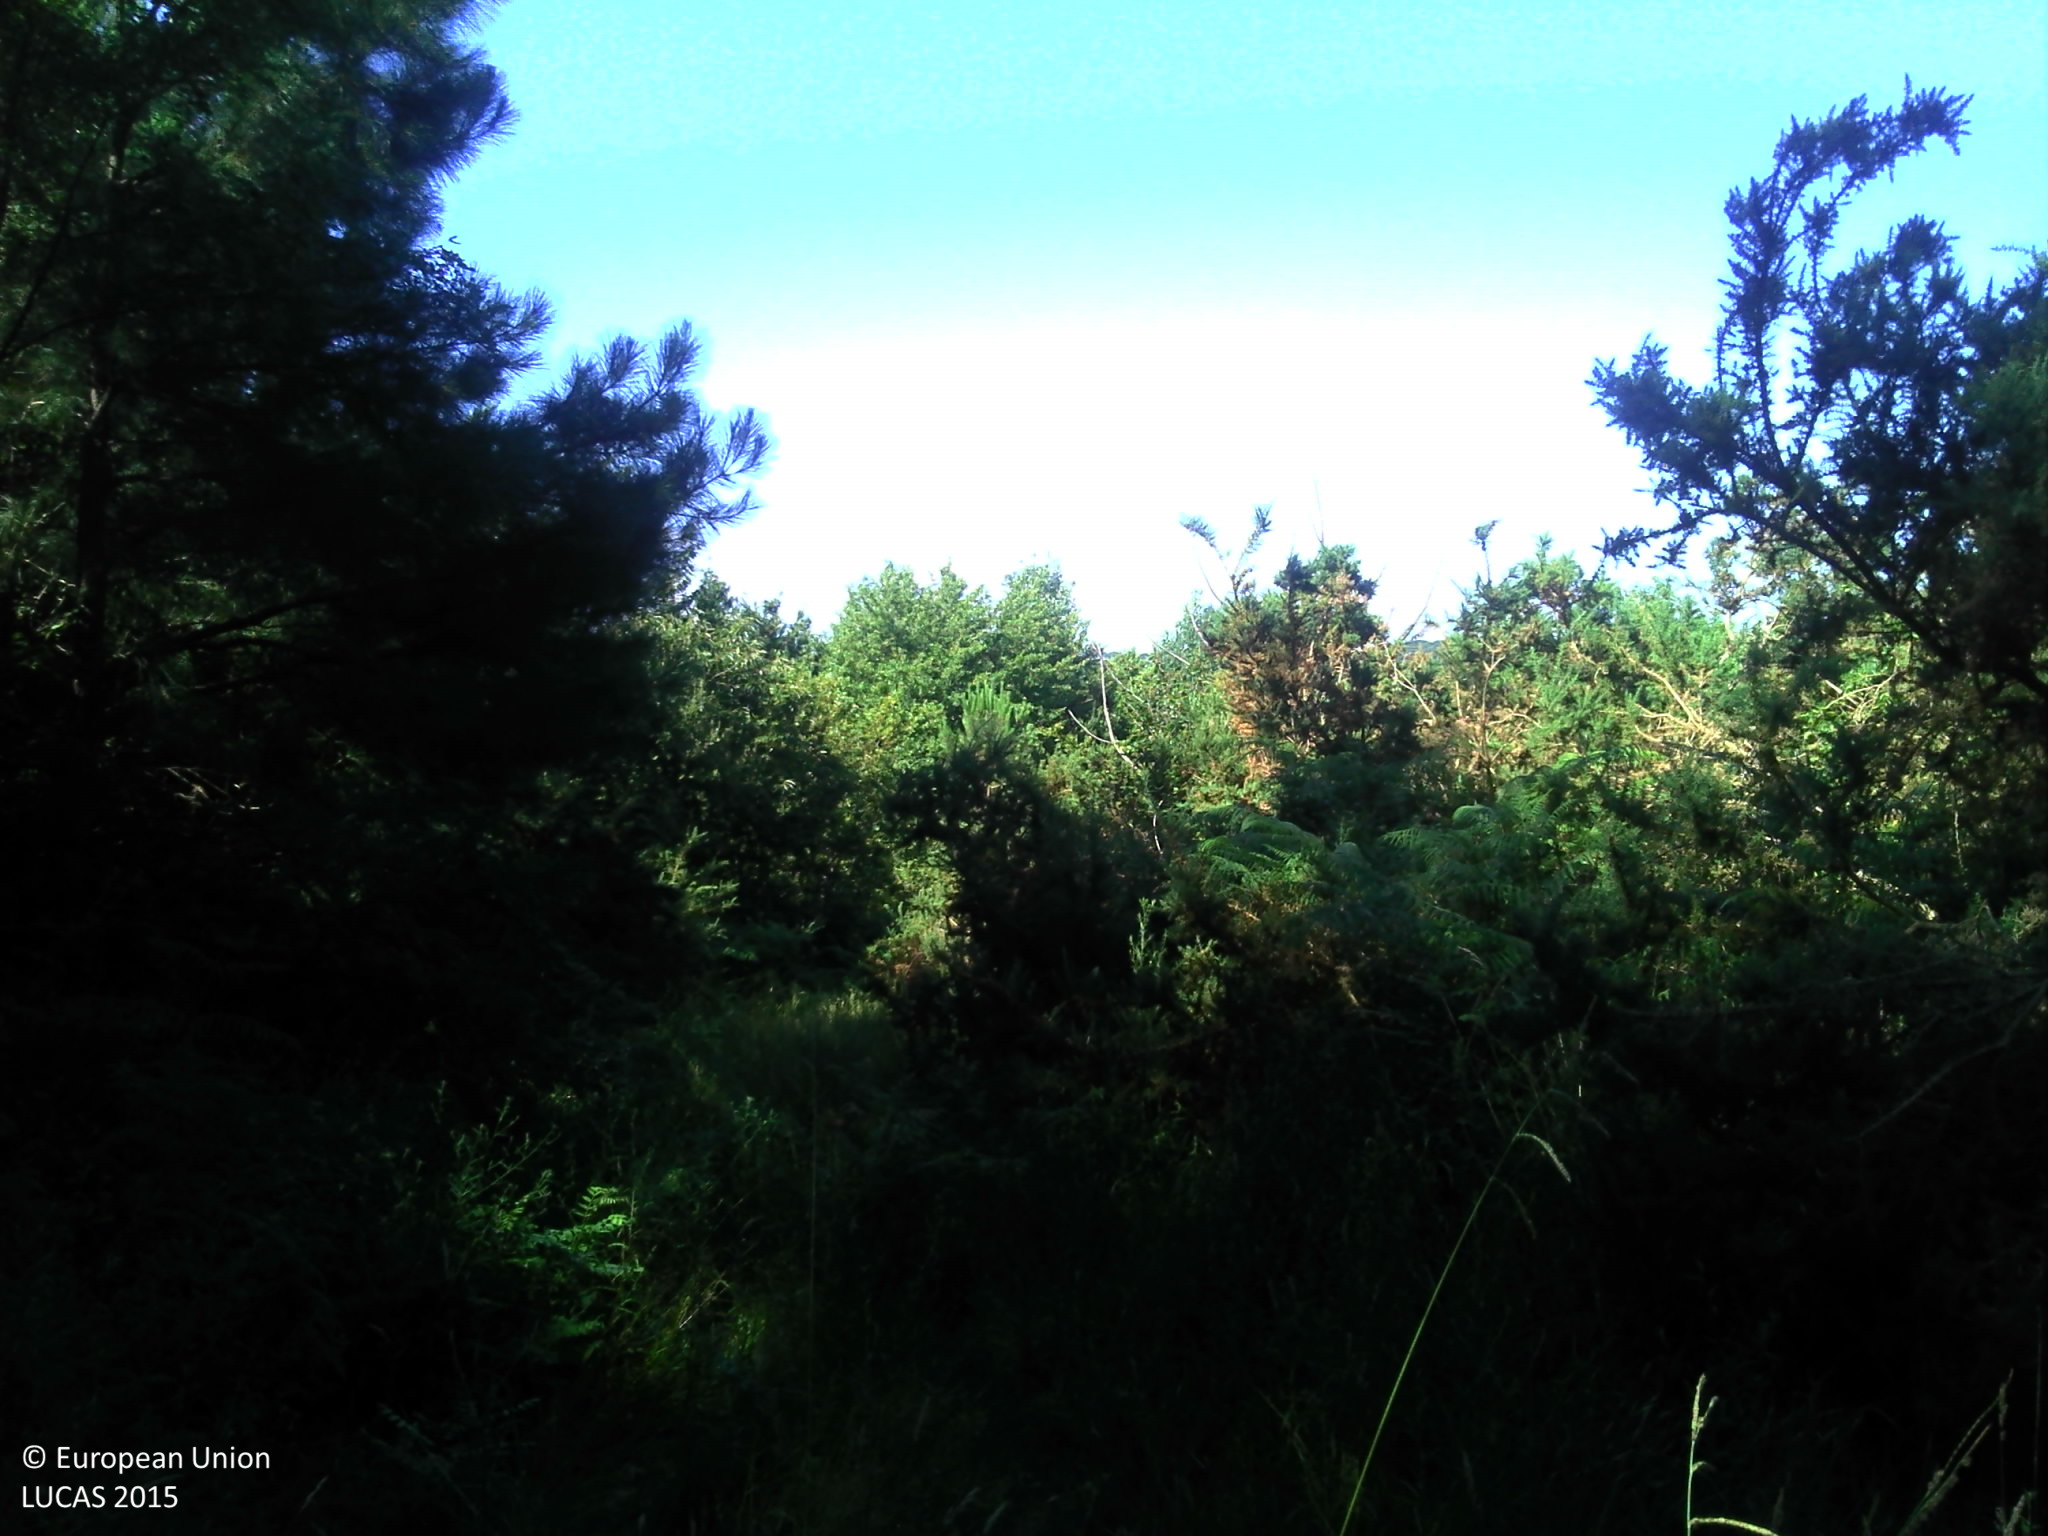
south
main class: Shrubland
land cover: Shrubland with sparse tree cover
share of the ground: > 75 %
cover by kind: shrubs 60 %, herbaceous plants 35 %, broadleaved forest trees 5 %
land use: Semi-natural and natural areas not in use
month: July
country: FR
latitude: 43.5893
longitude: -1.1005
